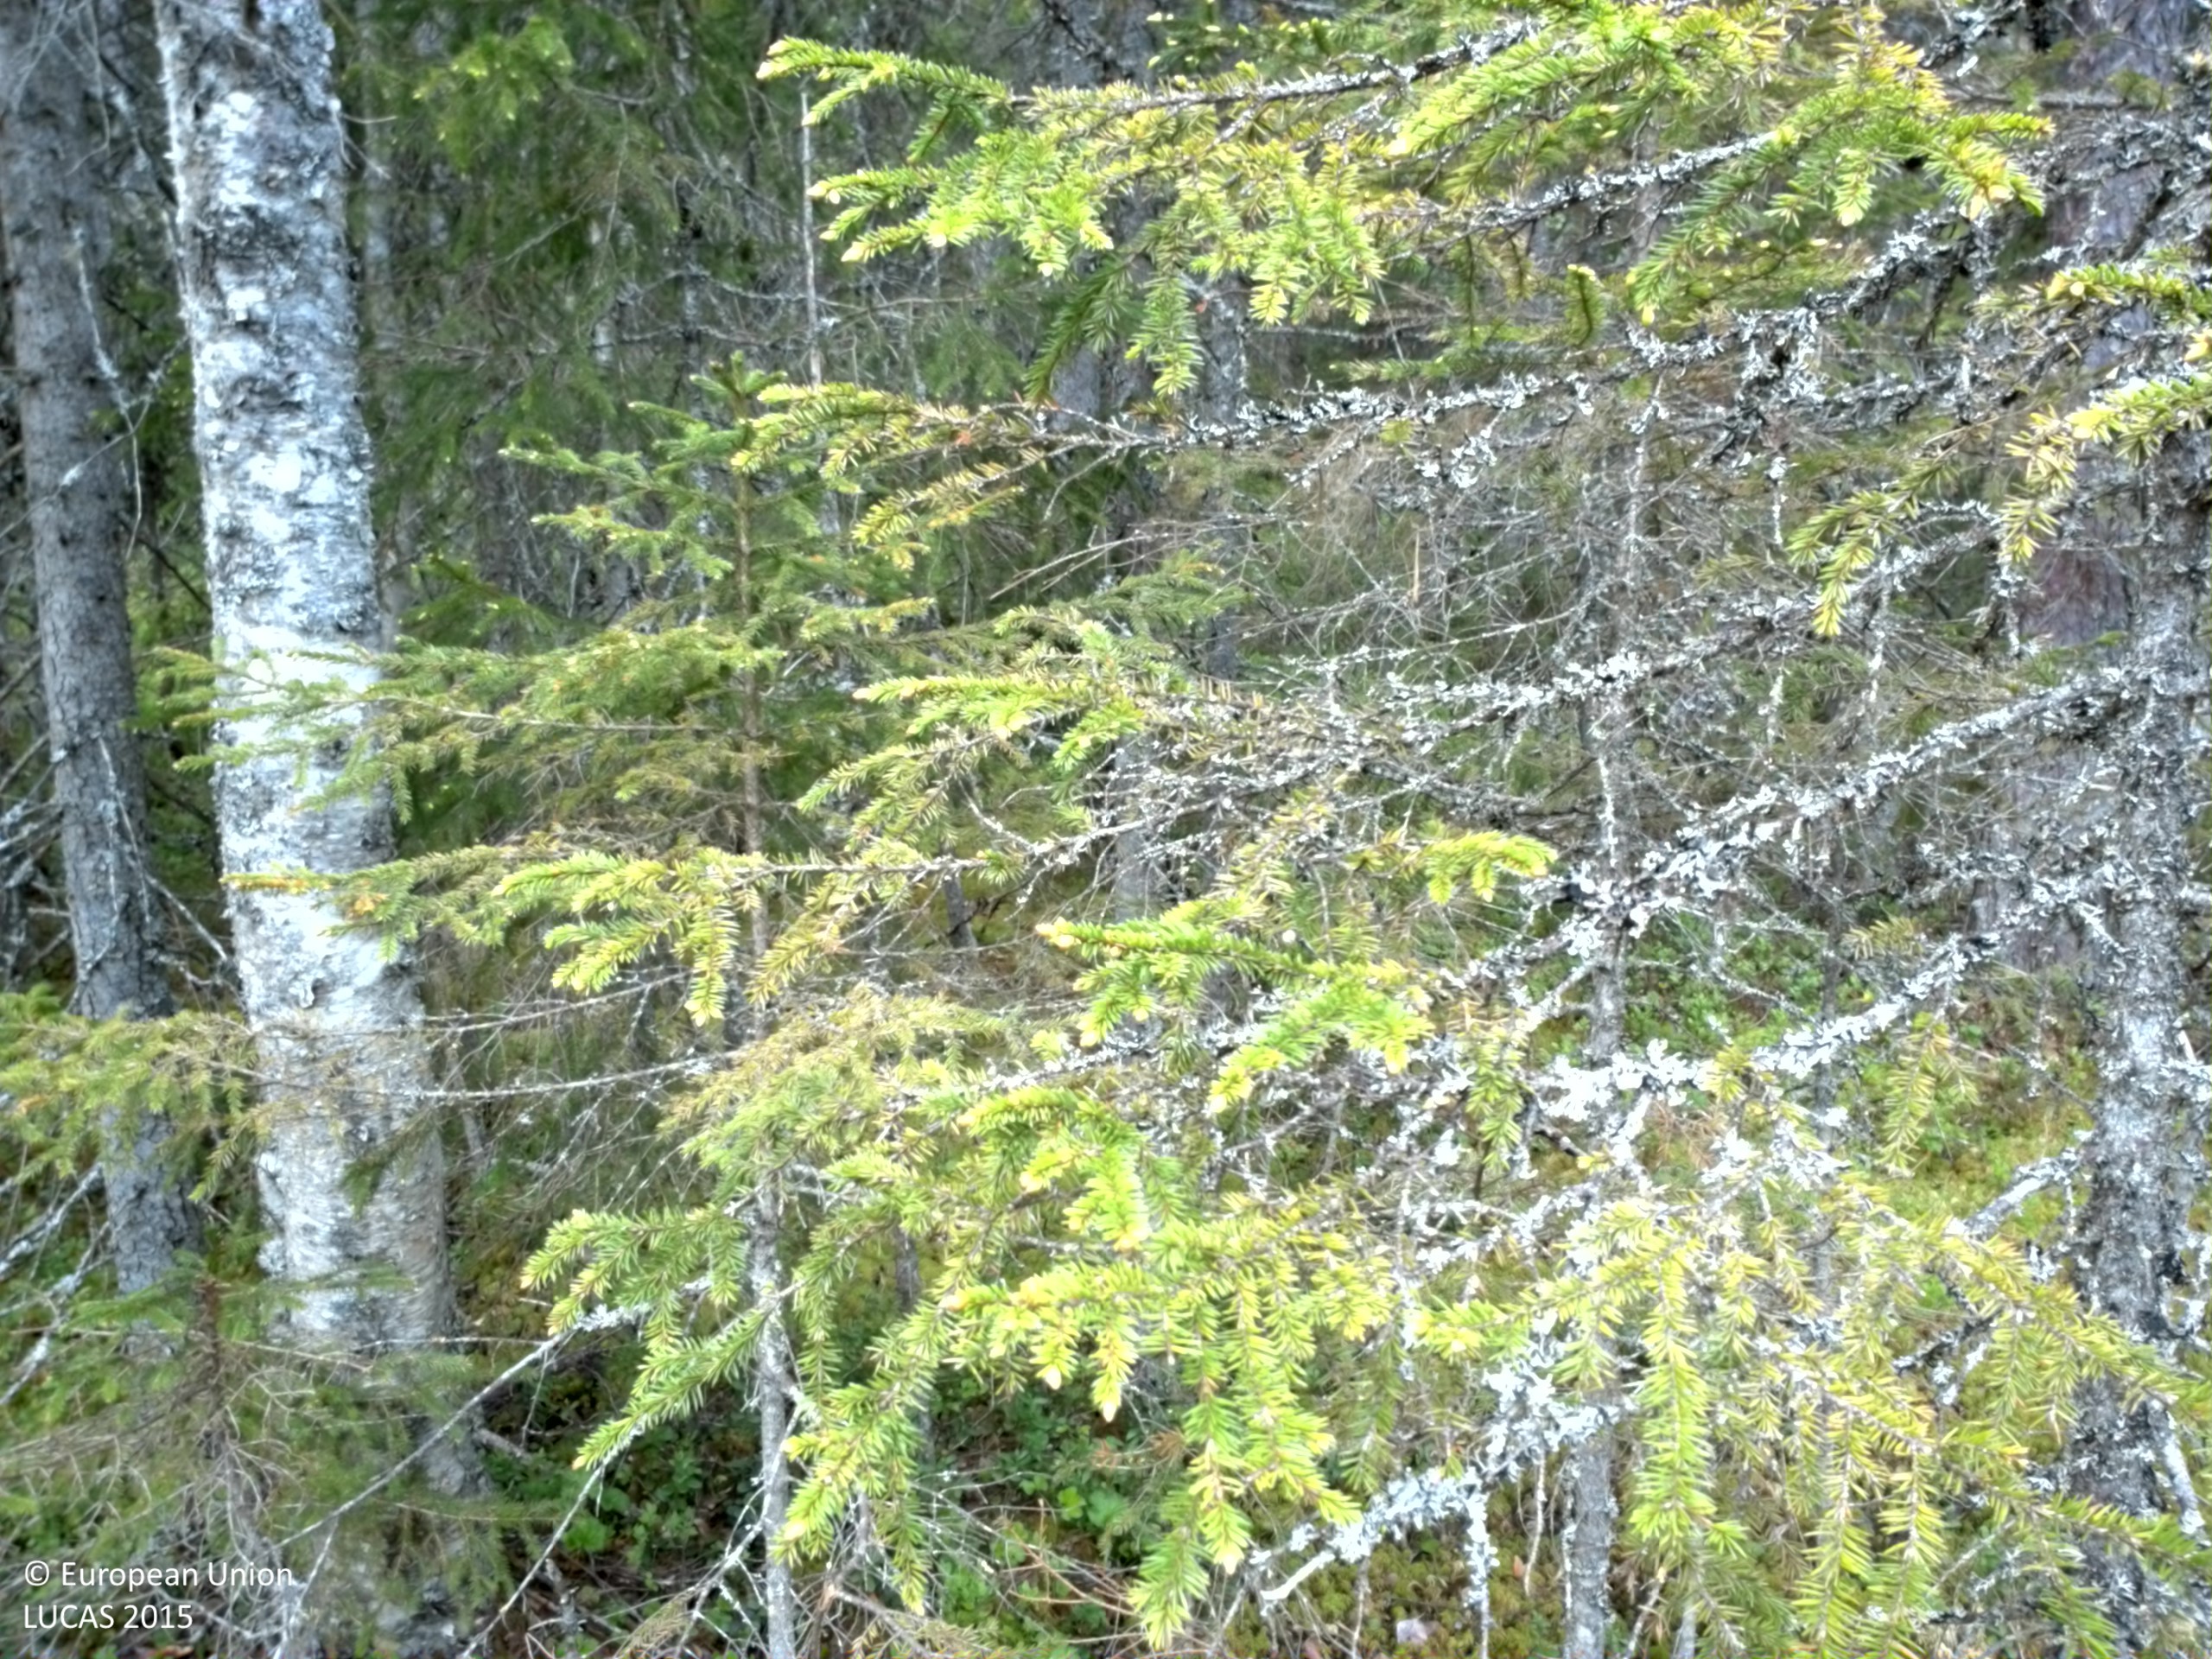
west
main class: Woodland
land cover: Other mixed woodland
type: boreal forest
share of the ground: > 75 %
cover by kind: coniferous forest trees 50 %, broadleaved forest trees 30 %, herbaceous plants 20 %
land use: Forestry
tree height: > 5 m
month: June
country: SE
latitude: 63.0365
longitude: 17.2316
